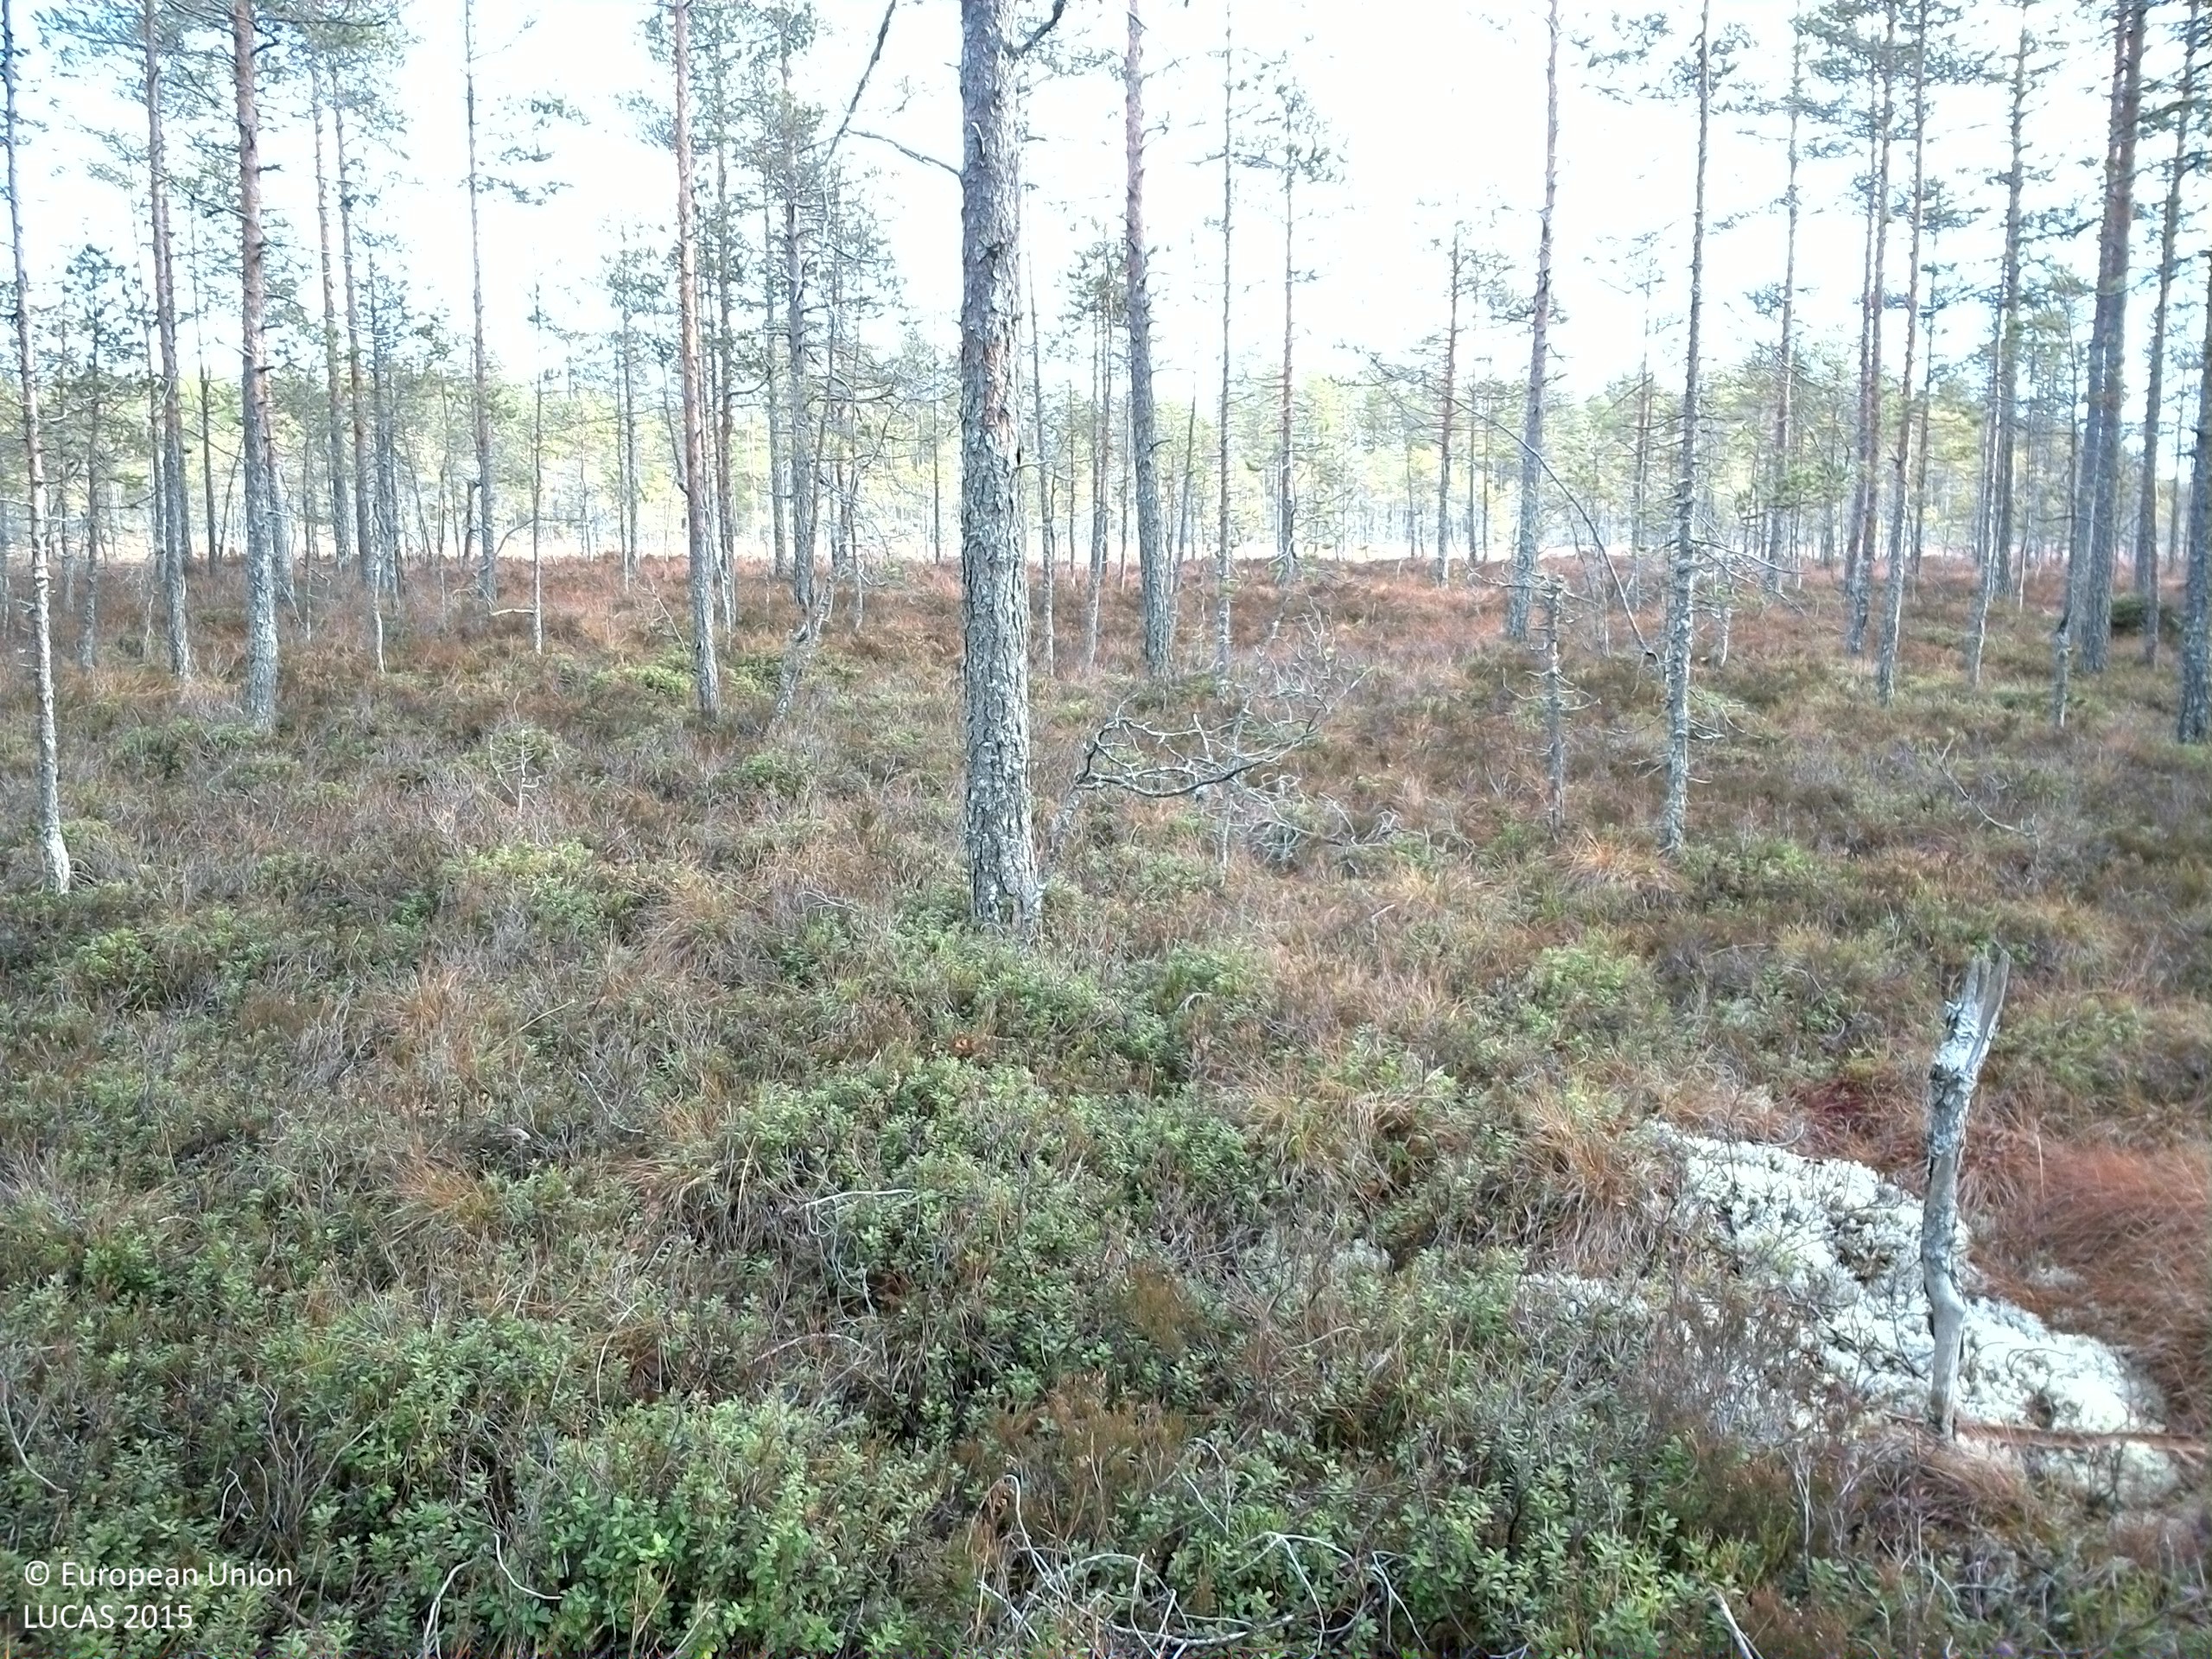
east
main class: Woodland
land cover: Pine dominated coniferous woodland
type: boreal forest
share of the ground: 50 - 75 %
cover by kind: coniferous forest trees 70 %, shrubs 25 %, lichens and mosses 5 %
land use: Forestry
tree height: > 5 m
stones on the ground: < 10 %
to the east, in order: Pine dominated coniferous woodland
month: November
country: SE
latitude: 60.1951
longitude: 14.6243
